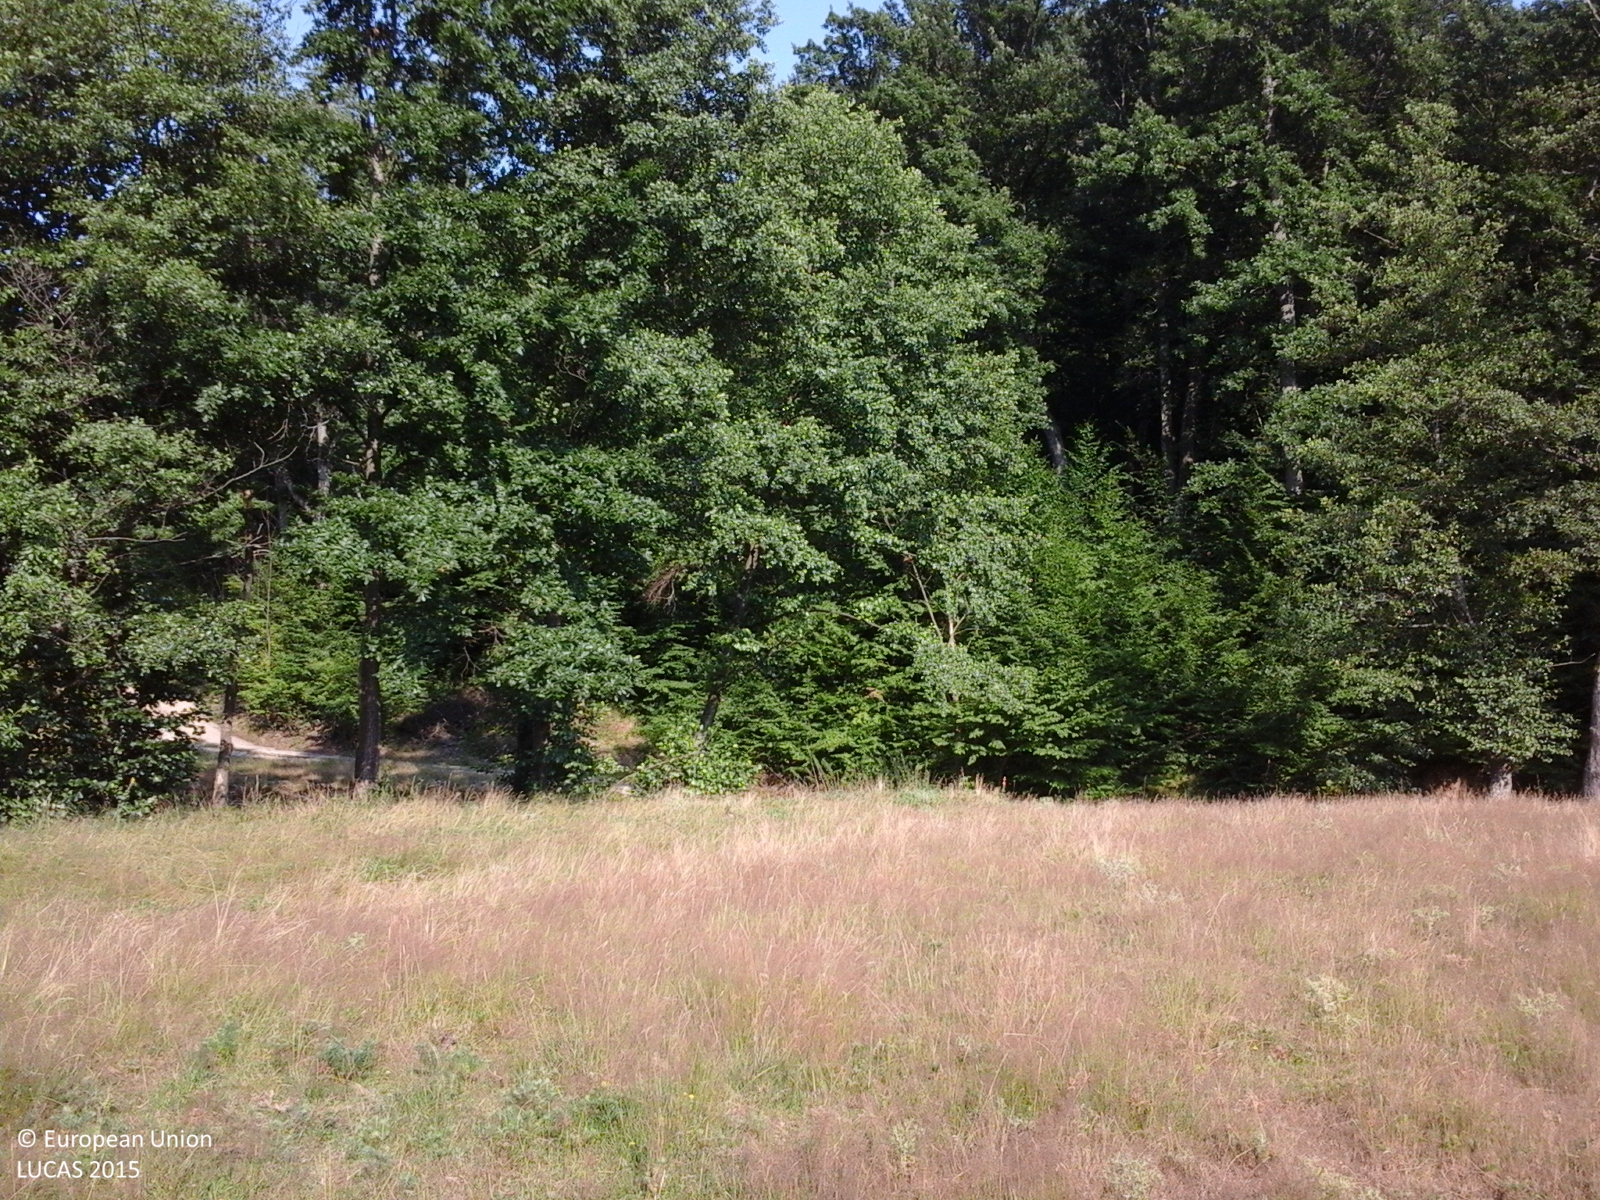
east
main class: Grassland
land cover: Grassland without tree/shrub cover
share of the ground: > 75 %
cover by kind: herbaceous plants 100 %
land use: Agriculture (excluding fallow land and kitchen gardens)
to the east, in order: Grassland without tree/shrub cover; Single bushes/trees; Ditches and canals; Grassland without tree/shrub cover; Tracks; Broadleaved woodland
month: July
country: RO
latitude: 44.9349
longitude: 24.5079
